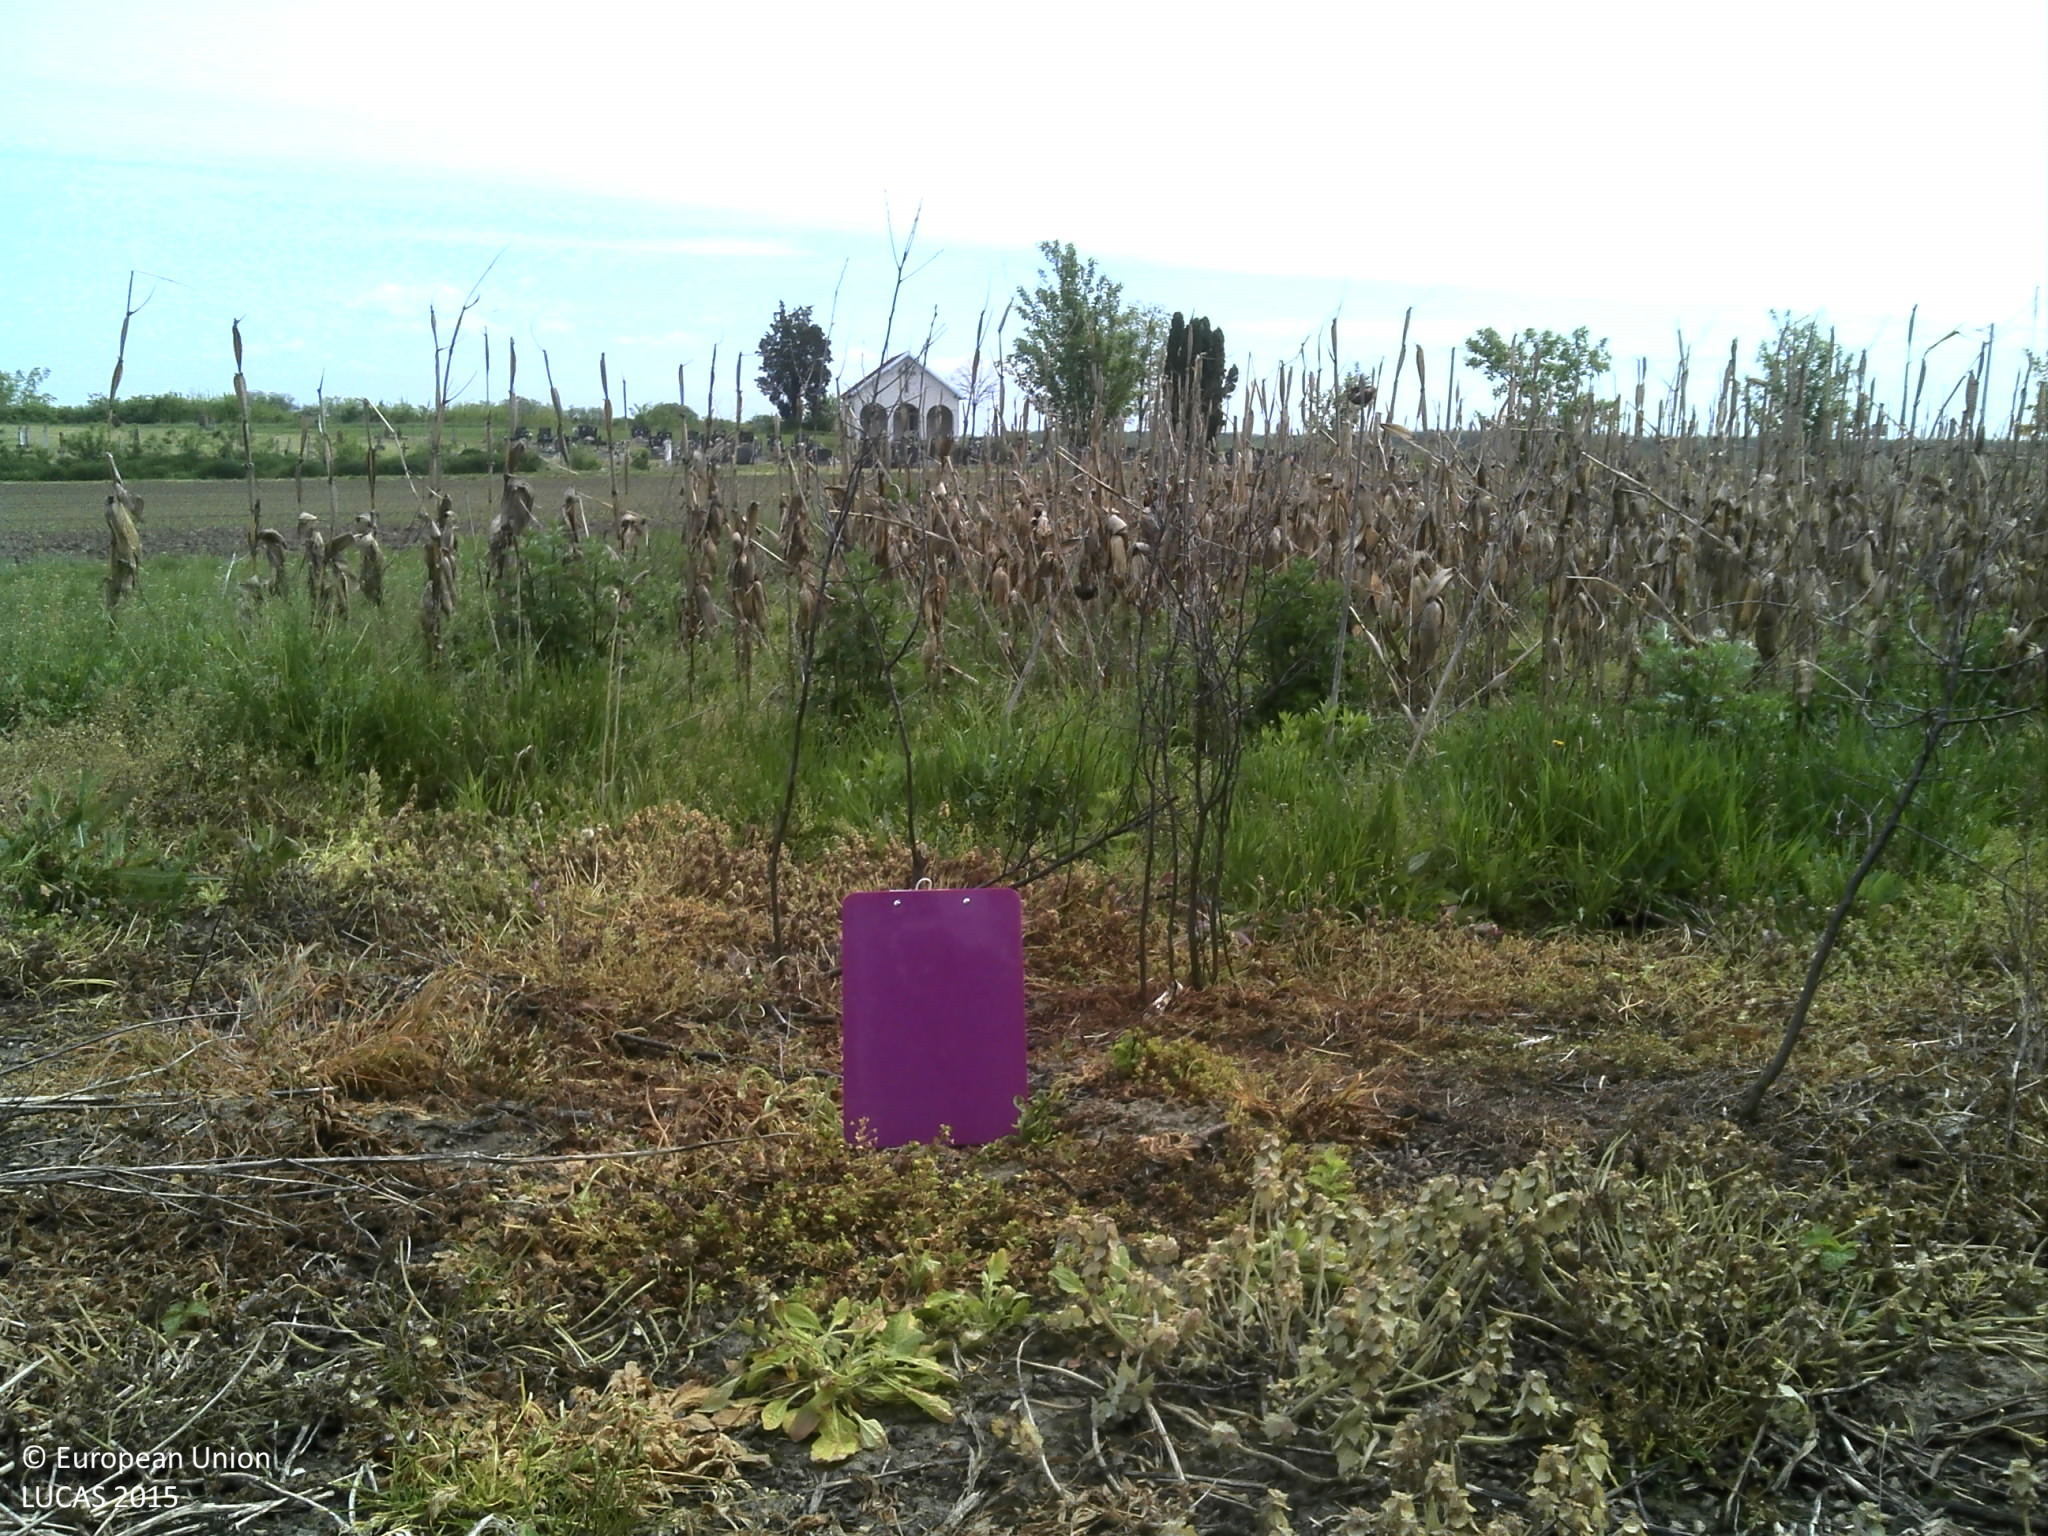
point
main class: Cropland
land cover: Other fruit trees and berries
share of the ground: > 75 %
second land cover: Spontaneously vegetated surfaces
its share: > 75 %
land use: Agriculture (excluding fallow land and kitchen gardens)
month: May
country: HR
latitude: 45.2383
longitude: 19.0916
